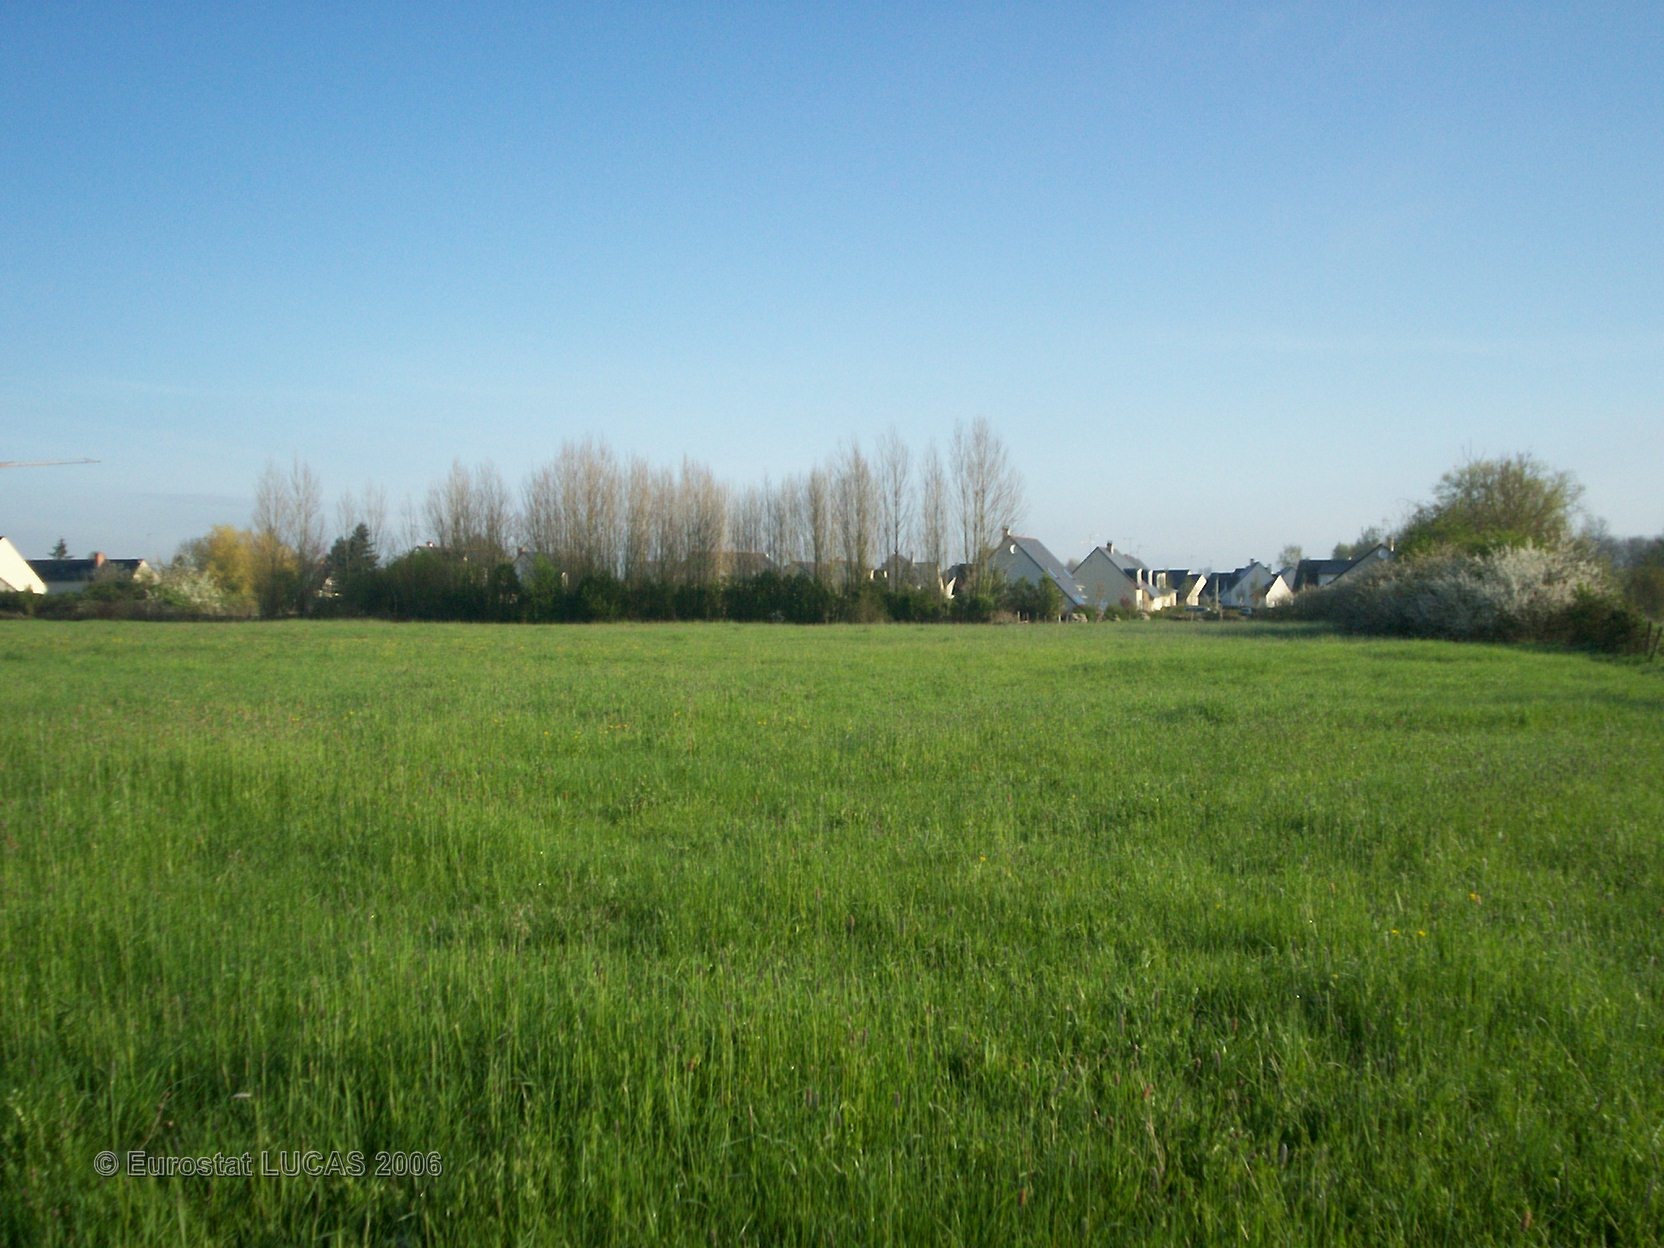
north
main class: Grassland
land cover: Grassland without tree/shrub cover
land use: Agriculture (excluding fallow land and kitchen gardens)
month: April
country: FR
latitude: 47.4922
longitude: -0.4231
